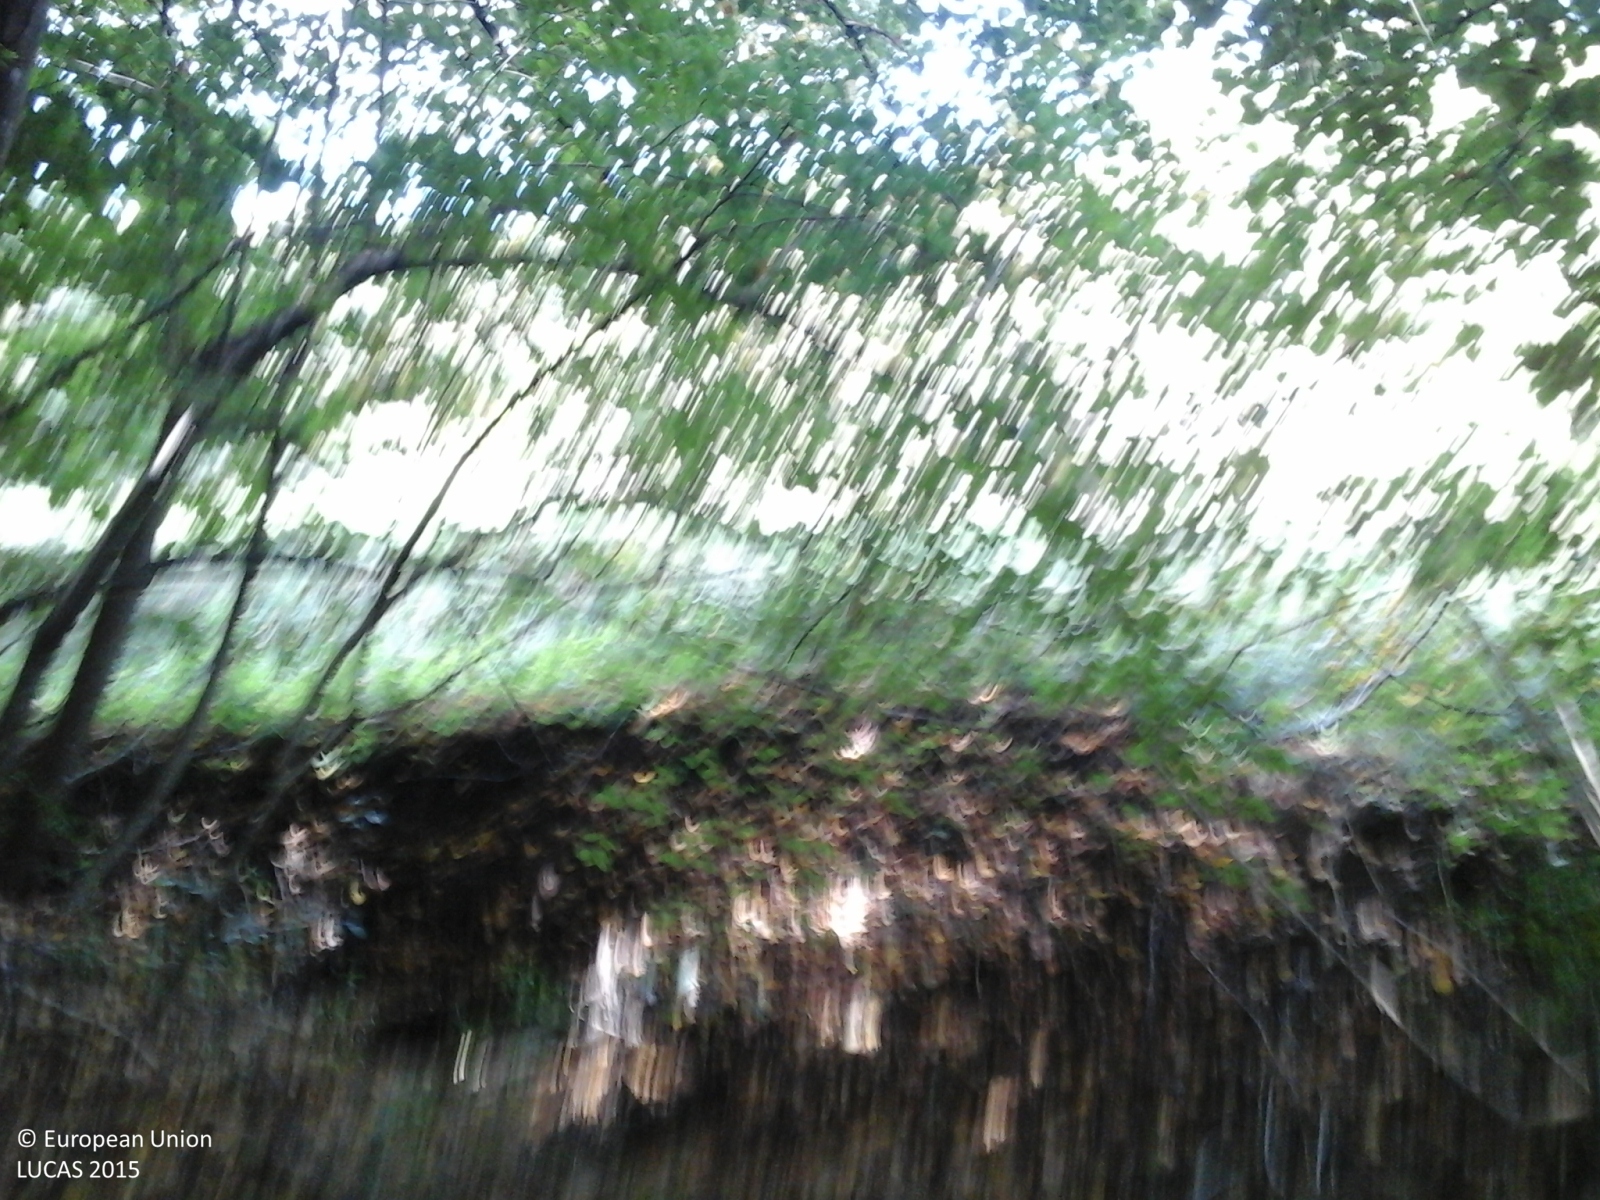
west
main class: Woodland
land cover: Broadleaved woodland
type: thermophilous deciduous forest
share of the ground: > 75 %
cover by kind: broadleaved forest trees 80 %, shrubs 20 %
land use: Semi-natural and natural areas not in use
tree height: > 5 m
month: September
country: IT
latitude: 44.5018
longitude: 8.4814
